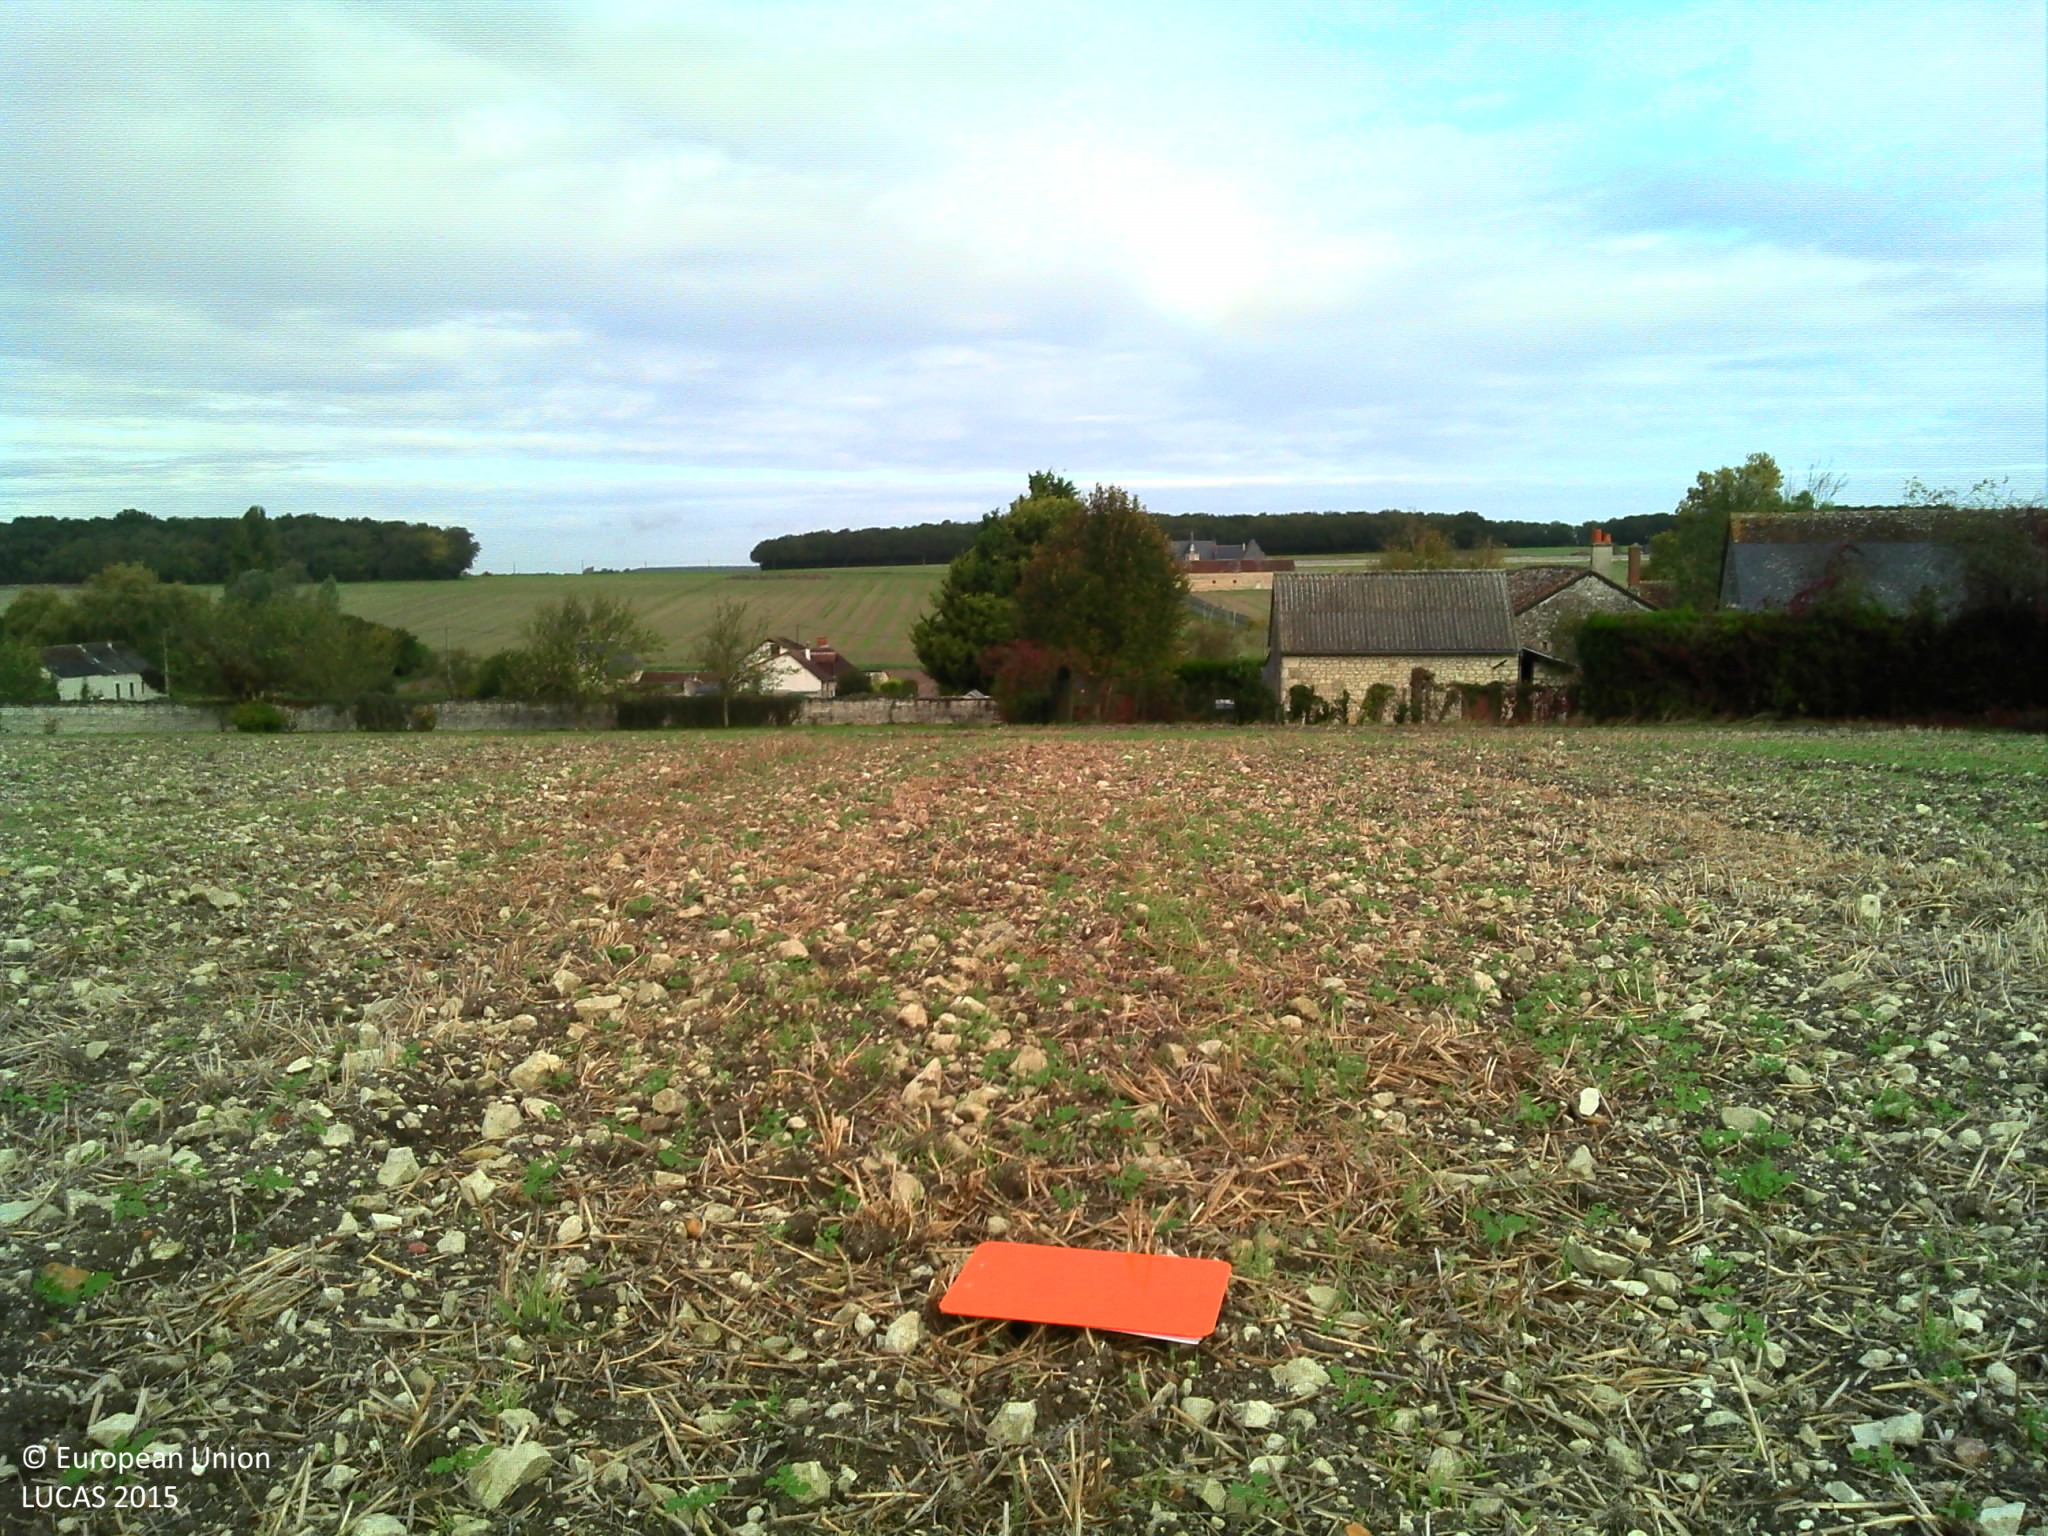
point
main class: Cropland
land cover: Barley
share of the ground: > 75 %
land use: Agriculture (excluding fallow land and kitchen gardens)
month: October
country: FR
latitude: 47.0752
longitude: 0.5645
